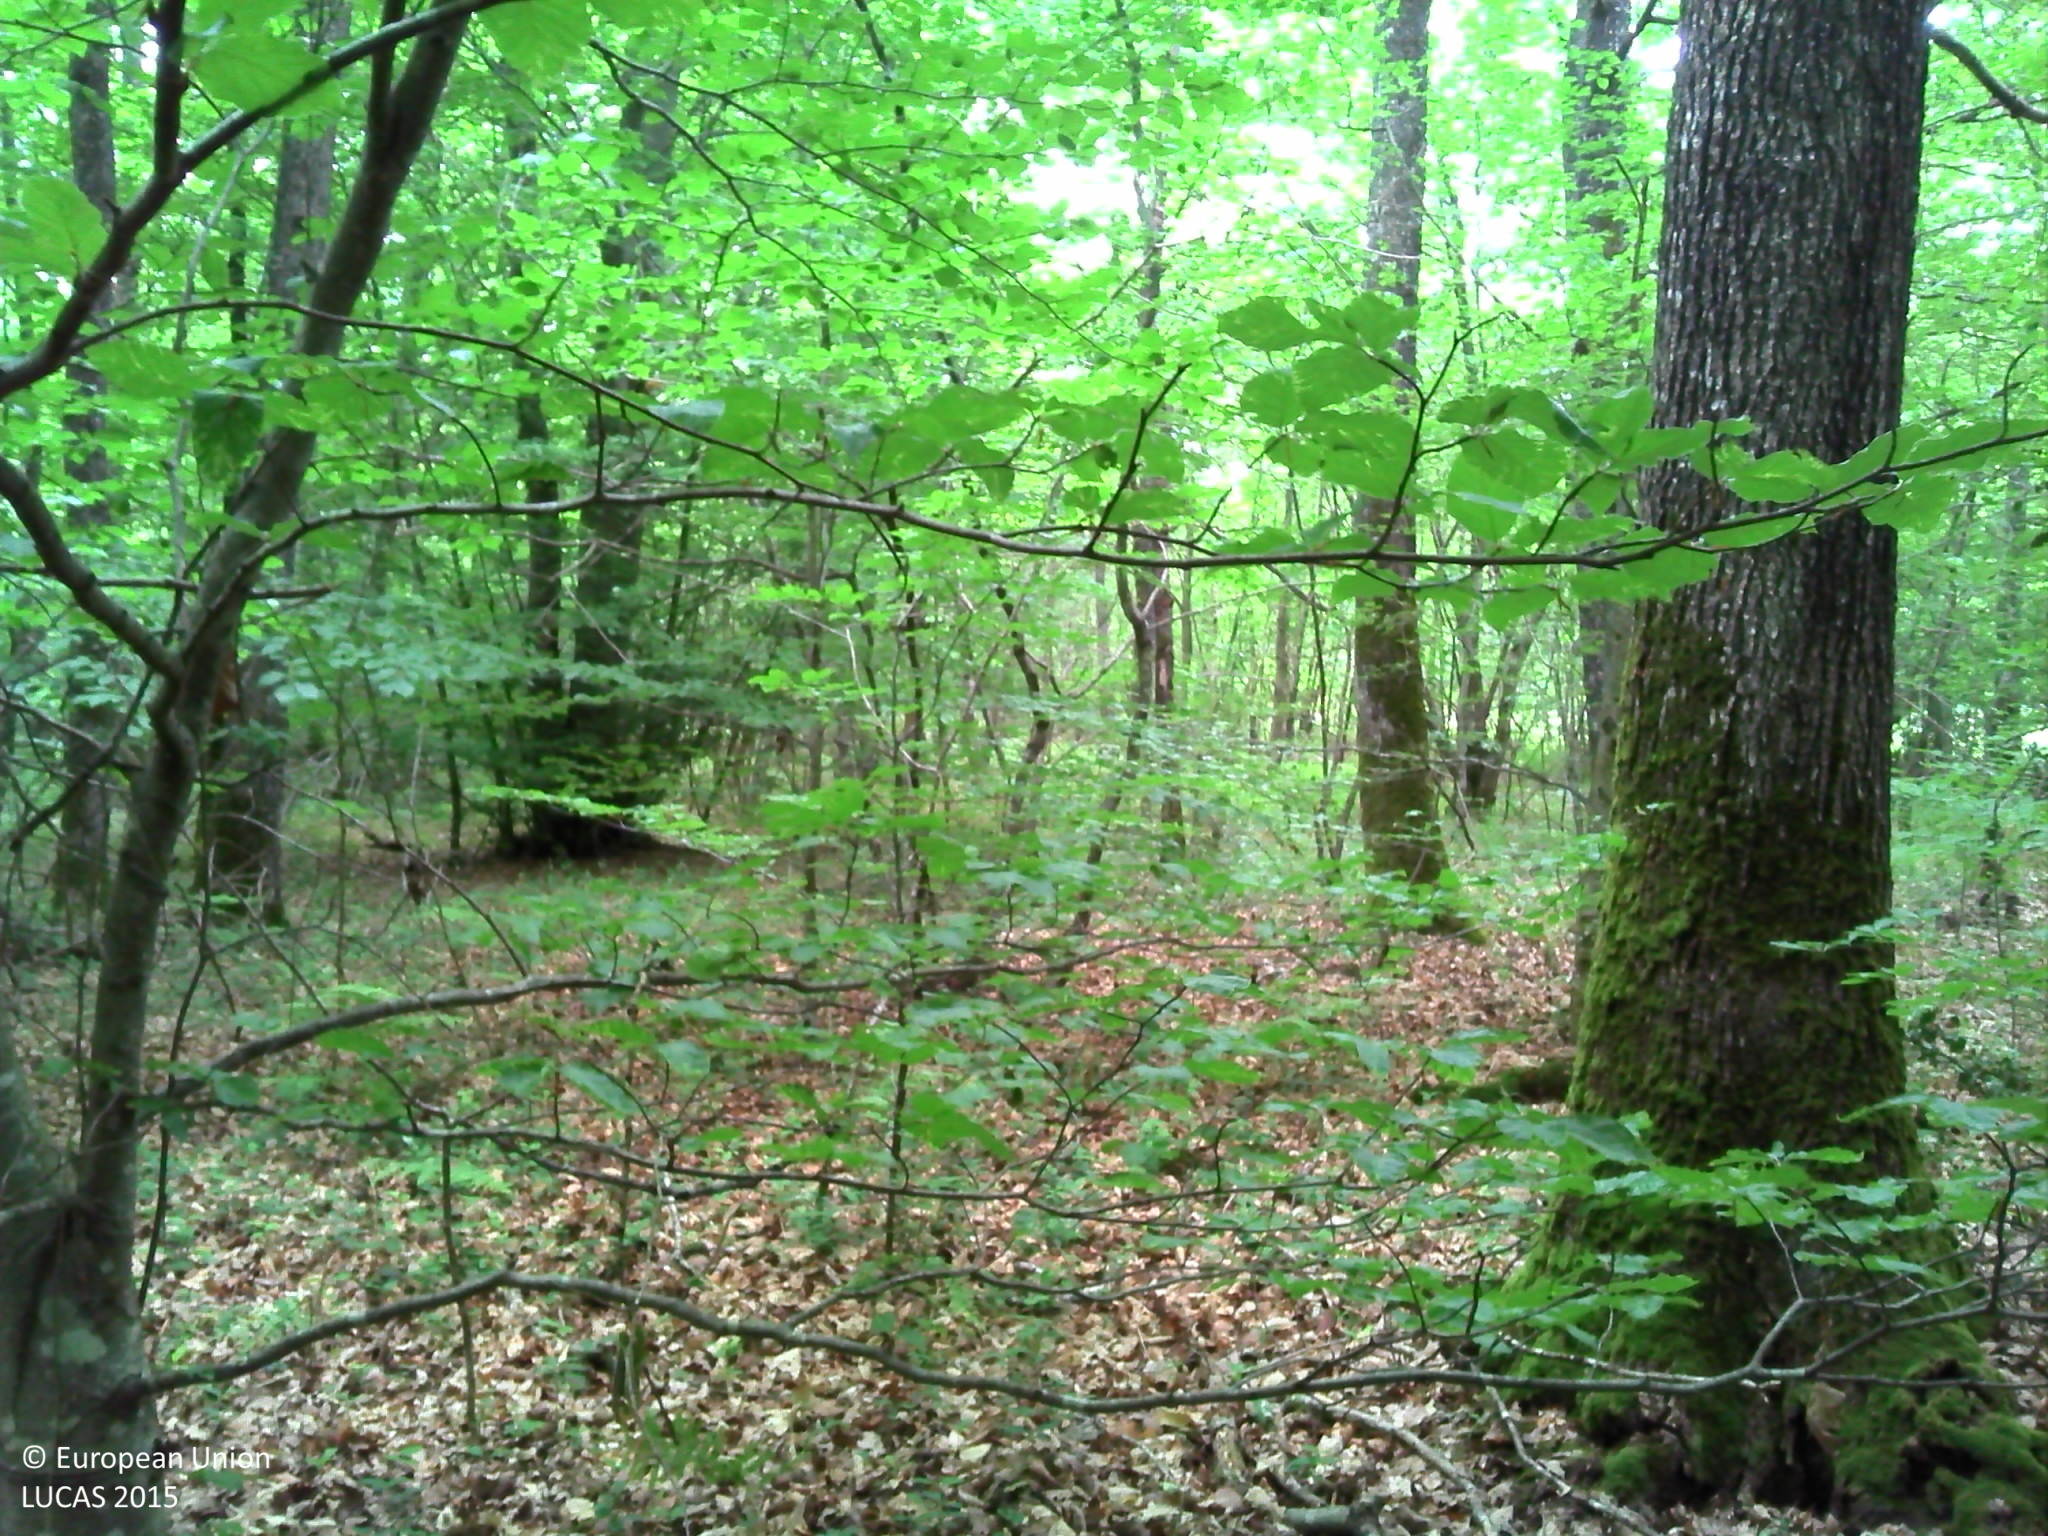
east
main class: Woodland
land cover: Broadleaved woodland
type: beech forest
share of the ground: > 75 %
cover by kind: broadleaved forest trees 90 %, shrubs 10 %
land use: Forestry
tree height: > 5 m
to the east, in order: Broadleaved woodland; Tracks; Grassland without tree/shrub cover; Ditches and canals; Grass margins; Paved roads, cycling and walking lanes; Grass margins
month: May
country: FR
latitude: 47.1358
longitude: 2.7559
